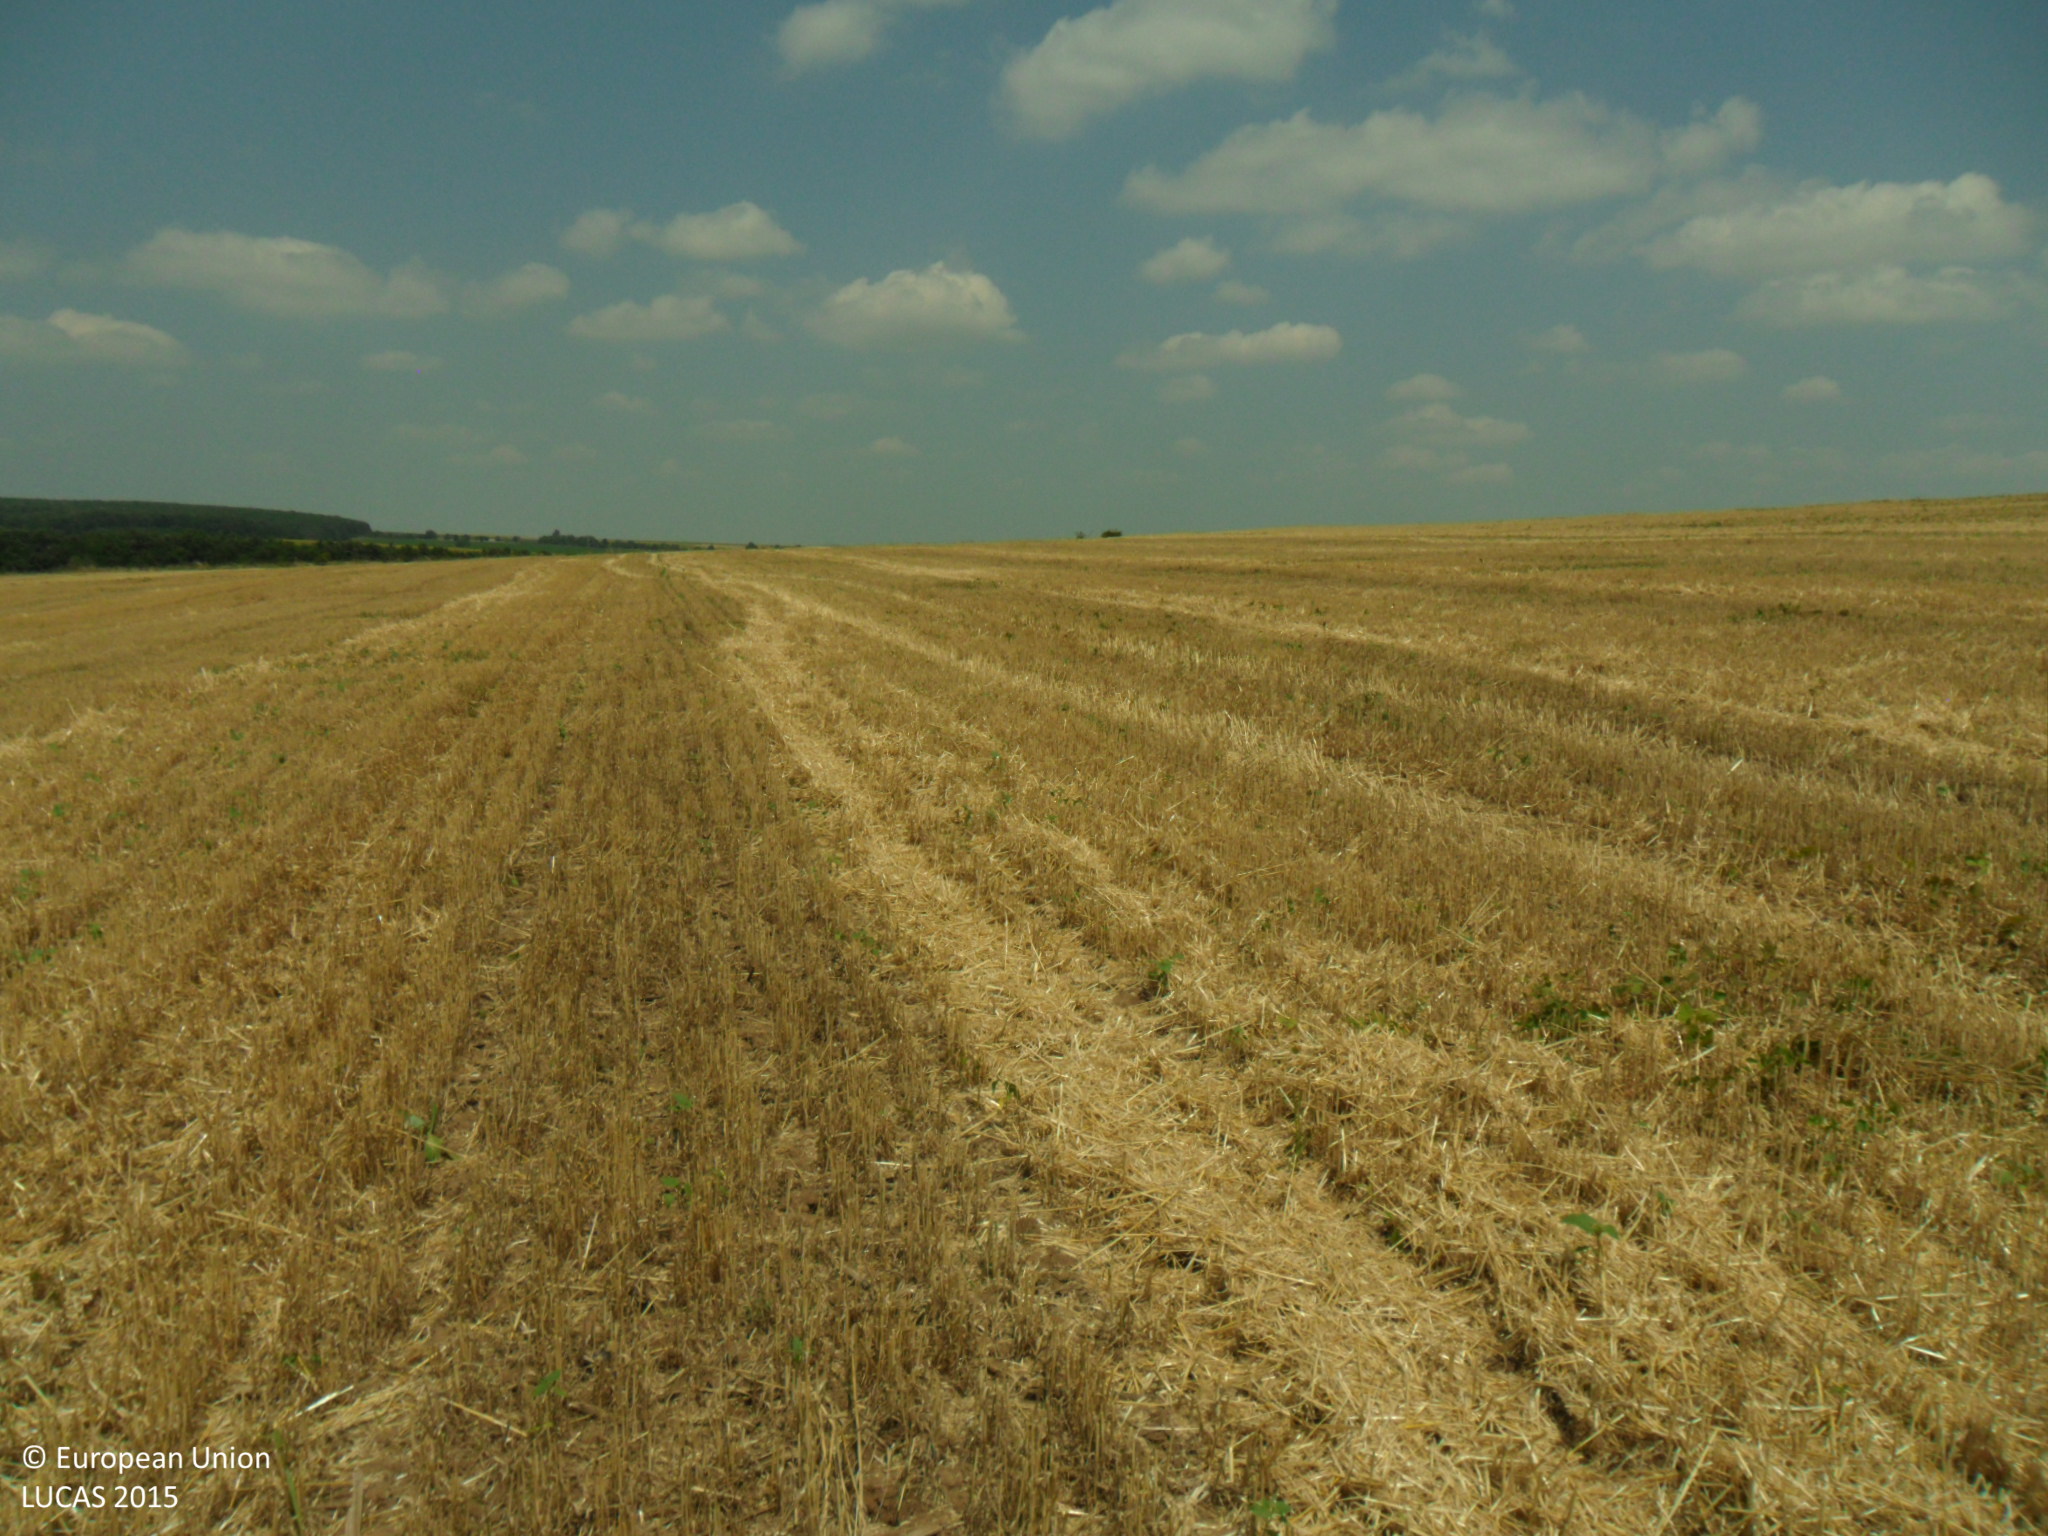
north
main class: Cropland
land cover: Common wheat
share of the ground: 25 - 50 %
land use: Agriculture (excluding fallow land and kitchen gardens)
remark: Harvested field
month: July
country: BG
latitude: 43.5528
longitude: 26.9385
